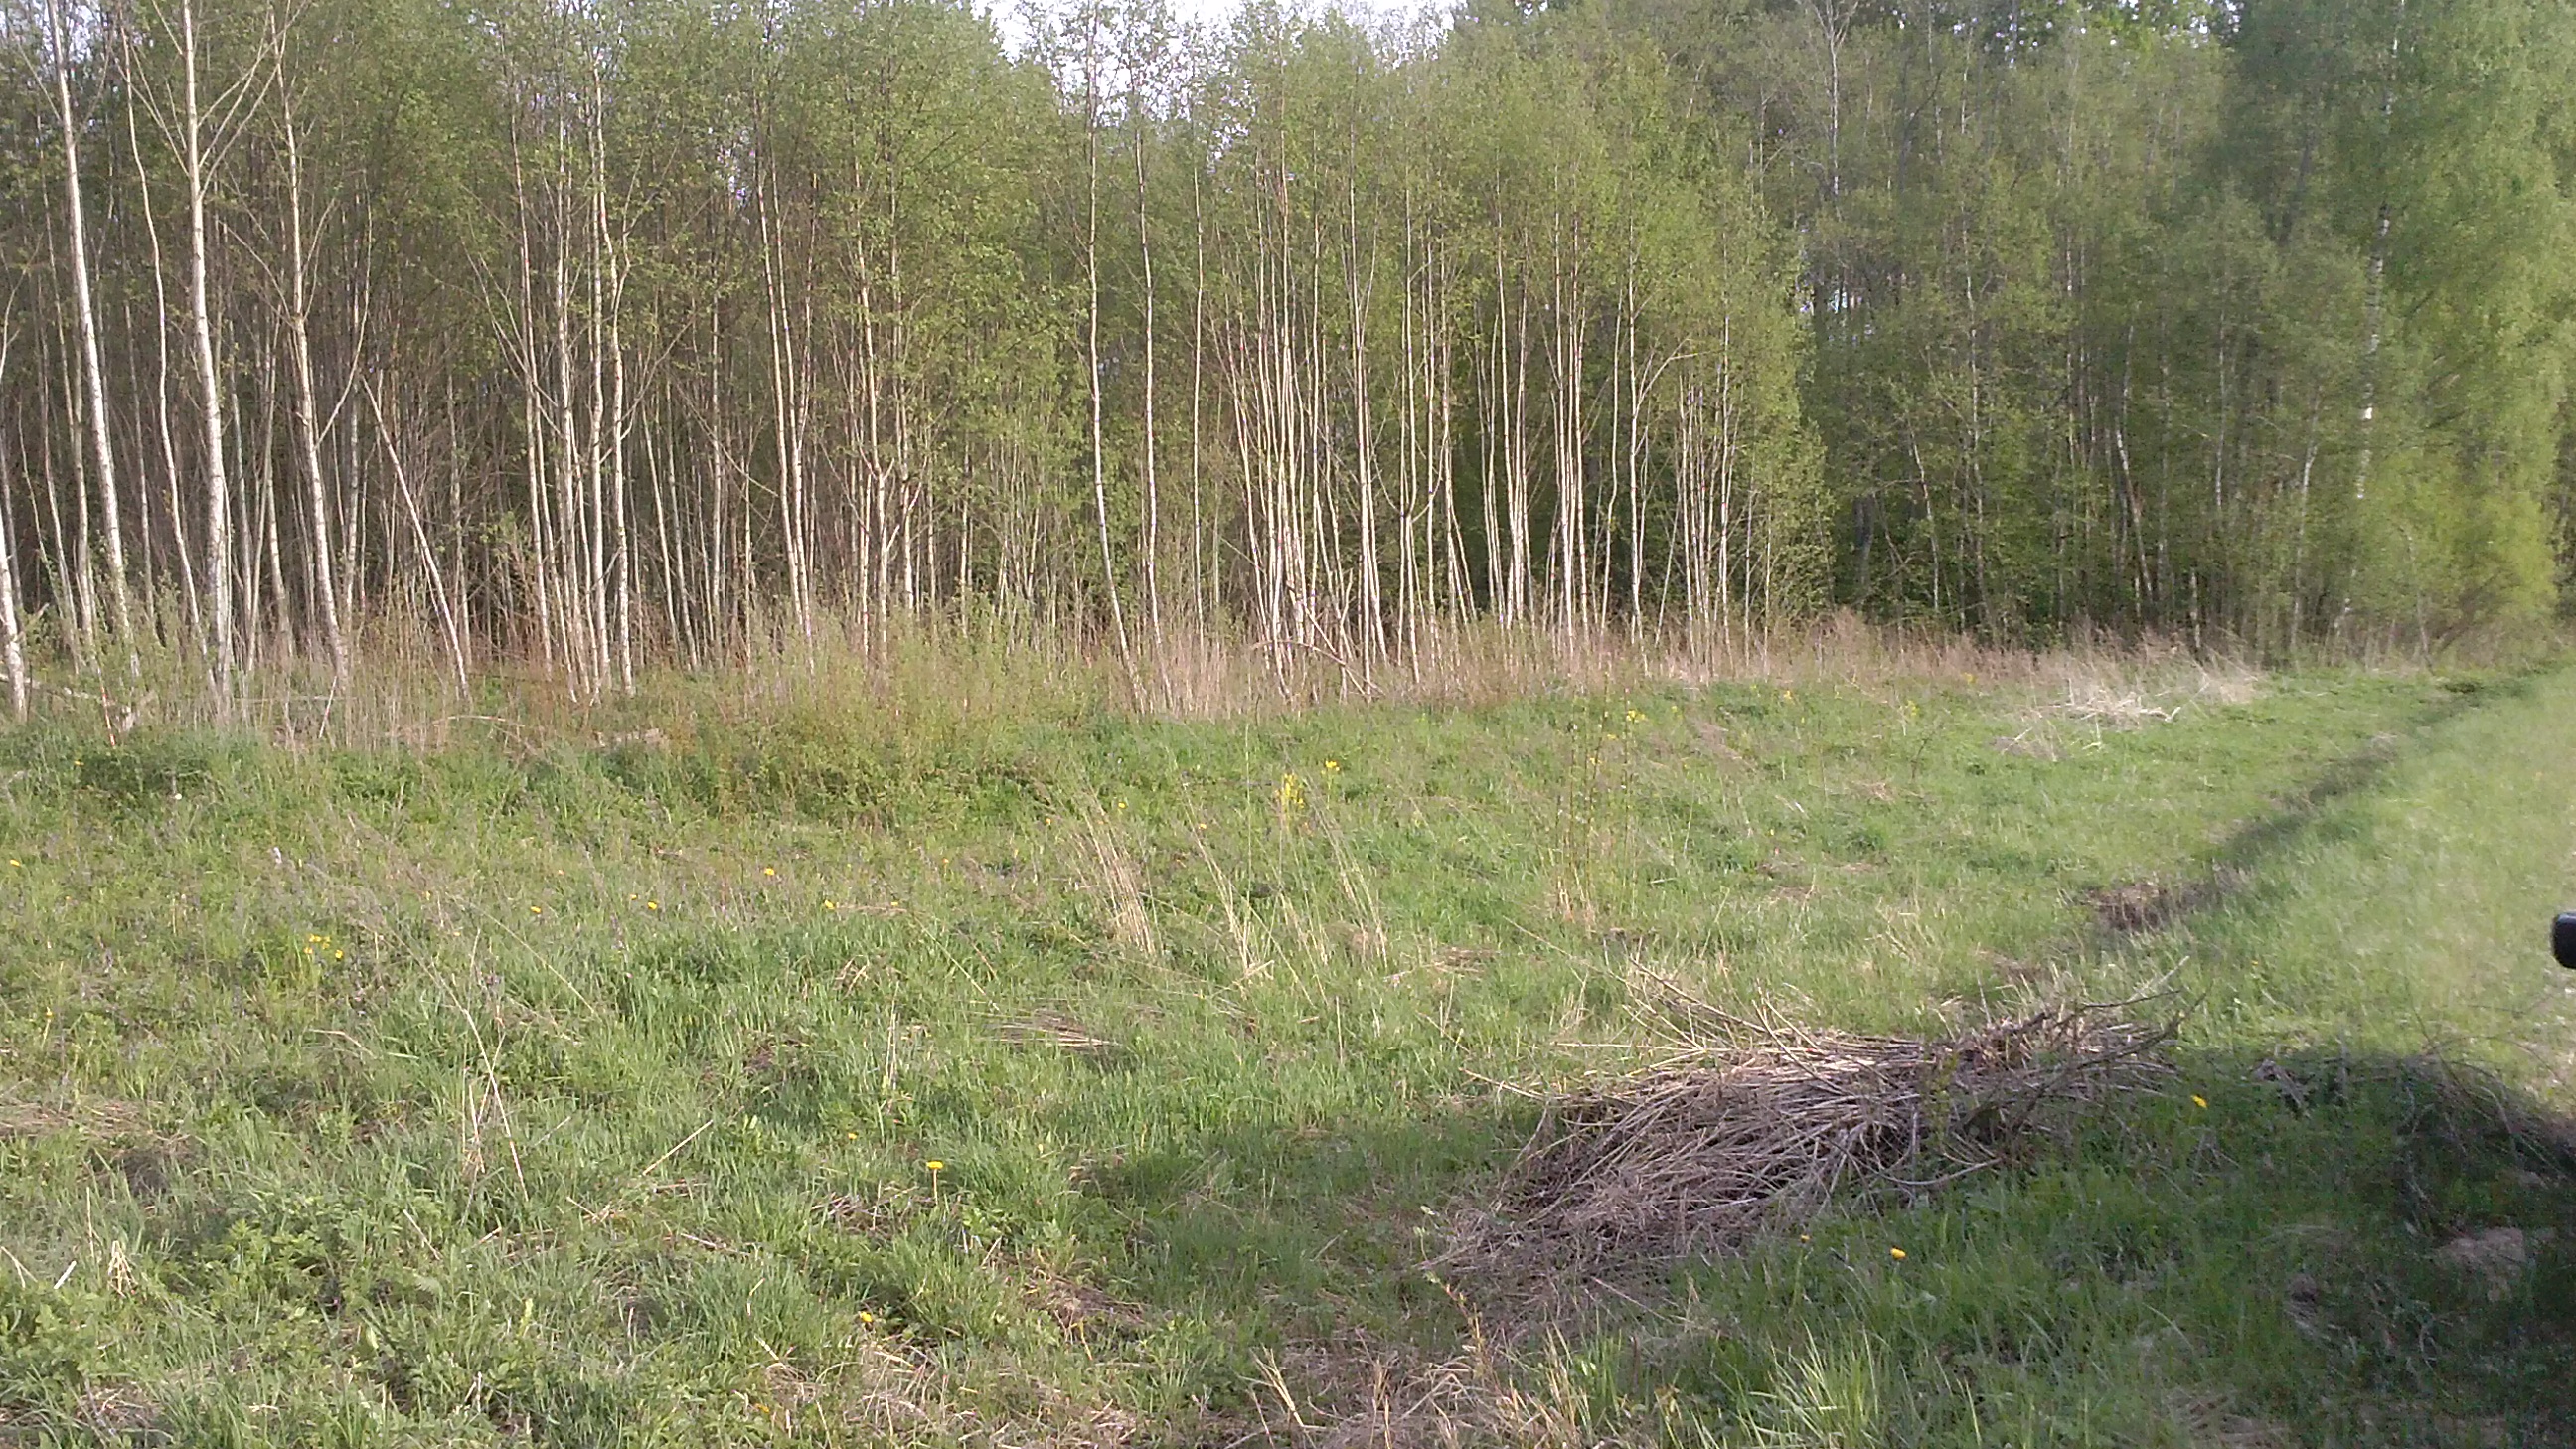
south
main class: Woodland
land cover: Broadleaved woodland
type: non-riverine alder, birch or aspen forest
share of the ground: > 75 %
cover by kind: broadleaved forest trees 100 %
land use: Forestry
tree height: > 5 m
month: May
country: LV
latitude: 56.0013
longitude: 27.7819
